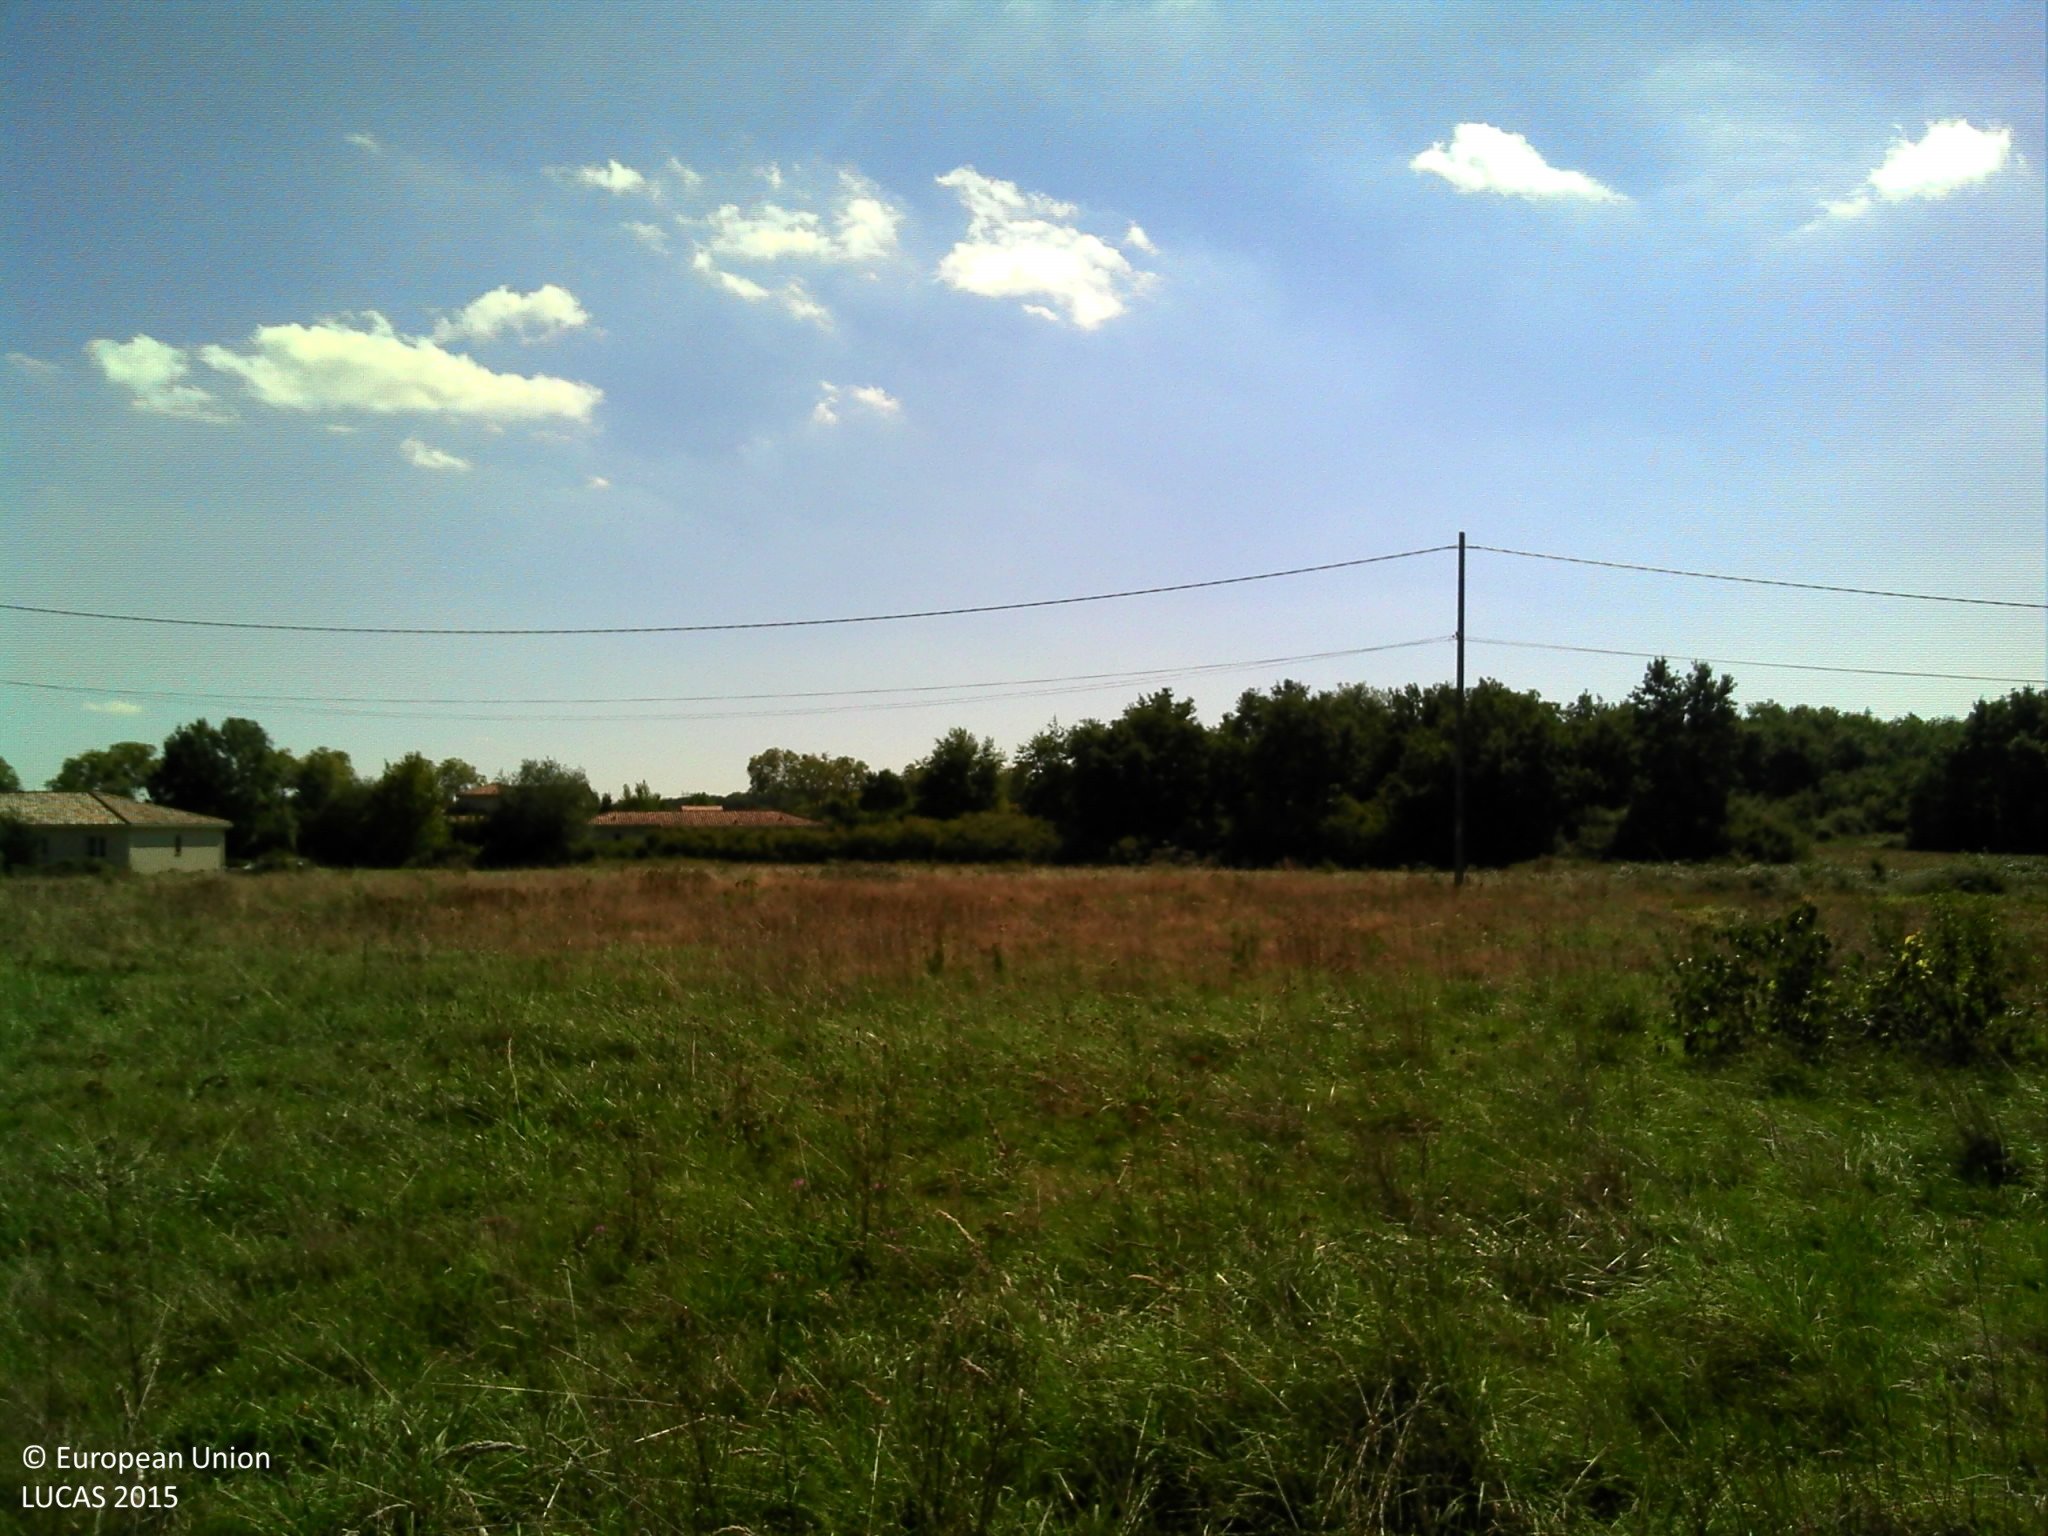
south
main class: Grassland
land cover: Grassland without tree/shrub cover
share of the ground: > 75 %
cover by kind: herbaceous plants 100 %
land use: Agriculture (excluding fallow land and kitchen gardens)
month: September
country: FR
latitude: 43.8738
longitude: 1.2767
